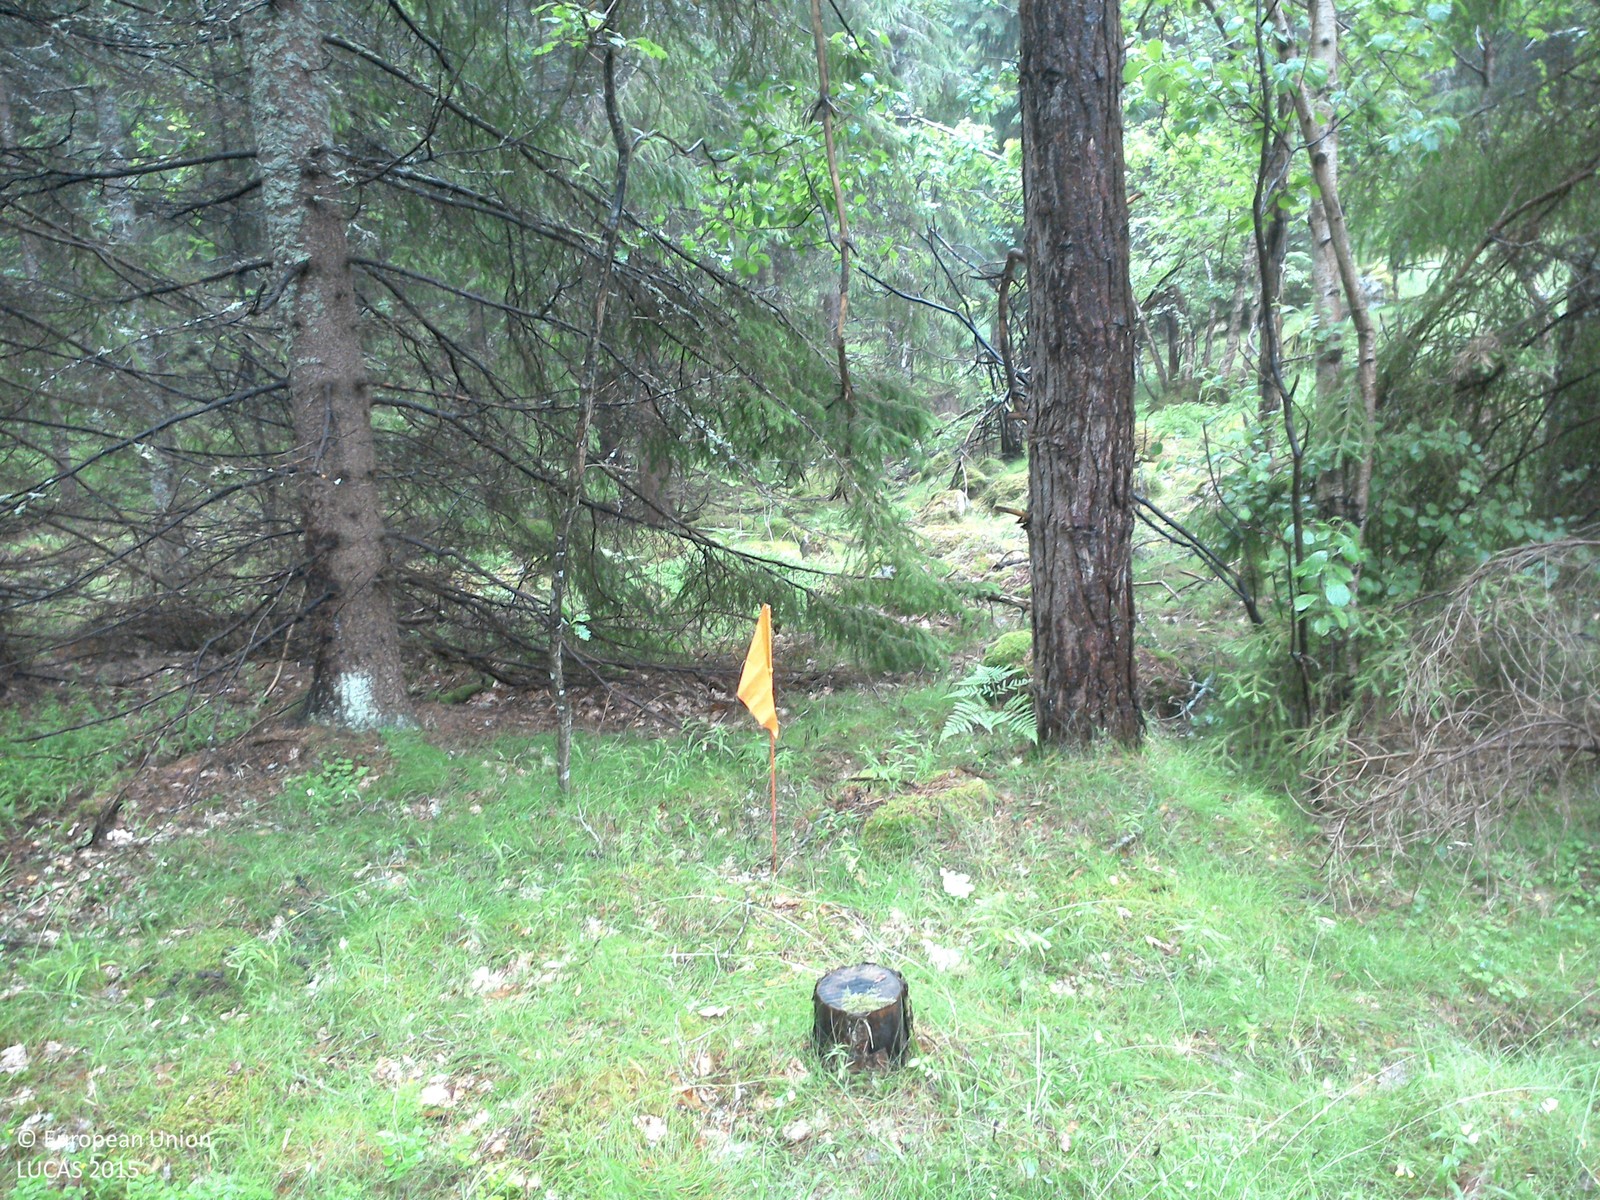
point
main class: Woodland
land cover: Pine dominated coniferous woodland
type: boreal forest
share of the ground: > 75 %
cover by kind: coniferous forest trees 75 %, herbaceous plants 20 %, lichens and mosses 5 %
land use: Forestry
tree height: > 5 m
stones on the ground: < 10 %
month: July
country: SE
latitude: 58.5940
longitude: 15.0346
